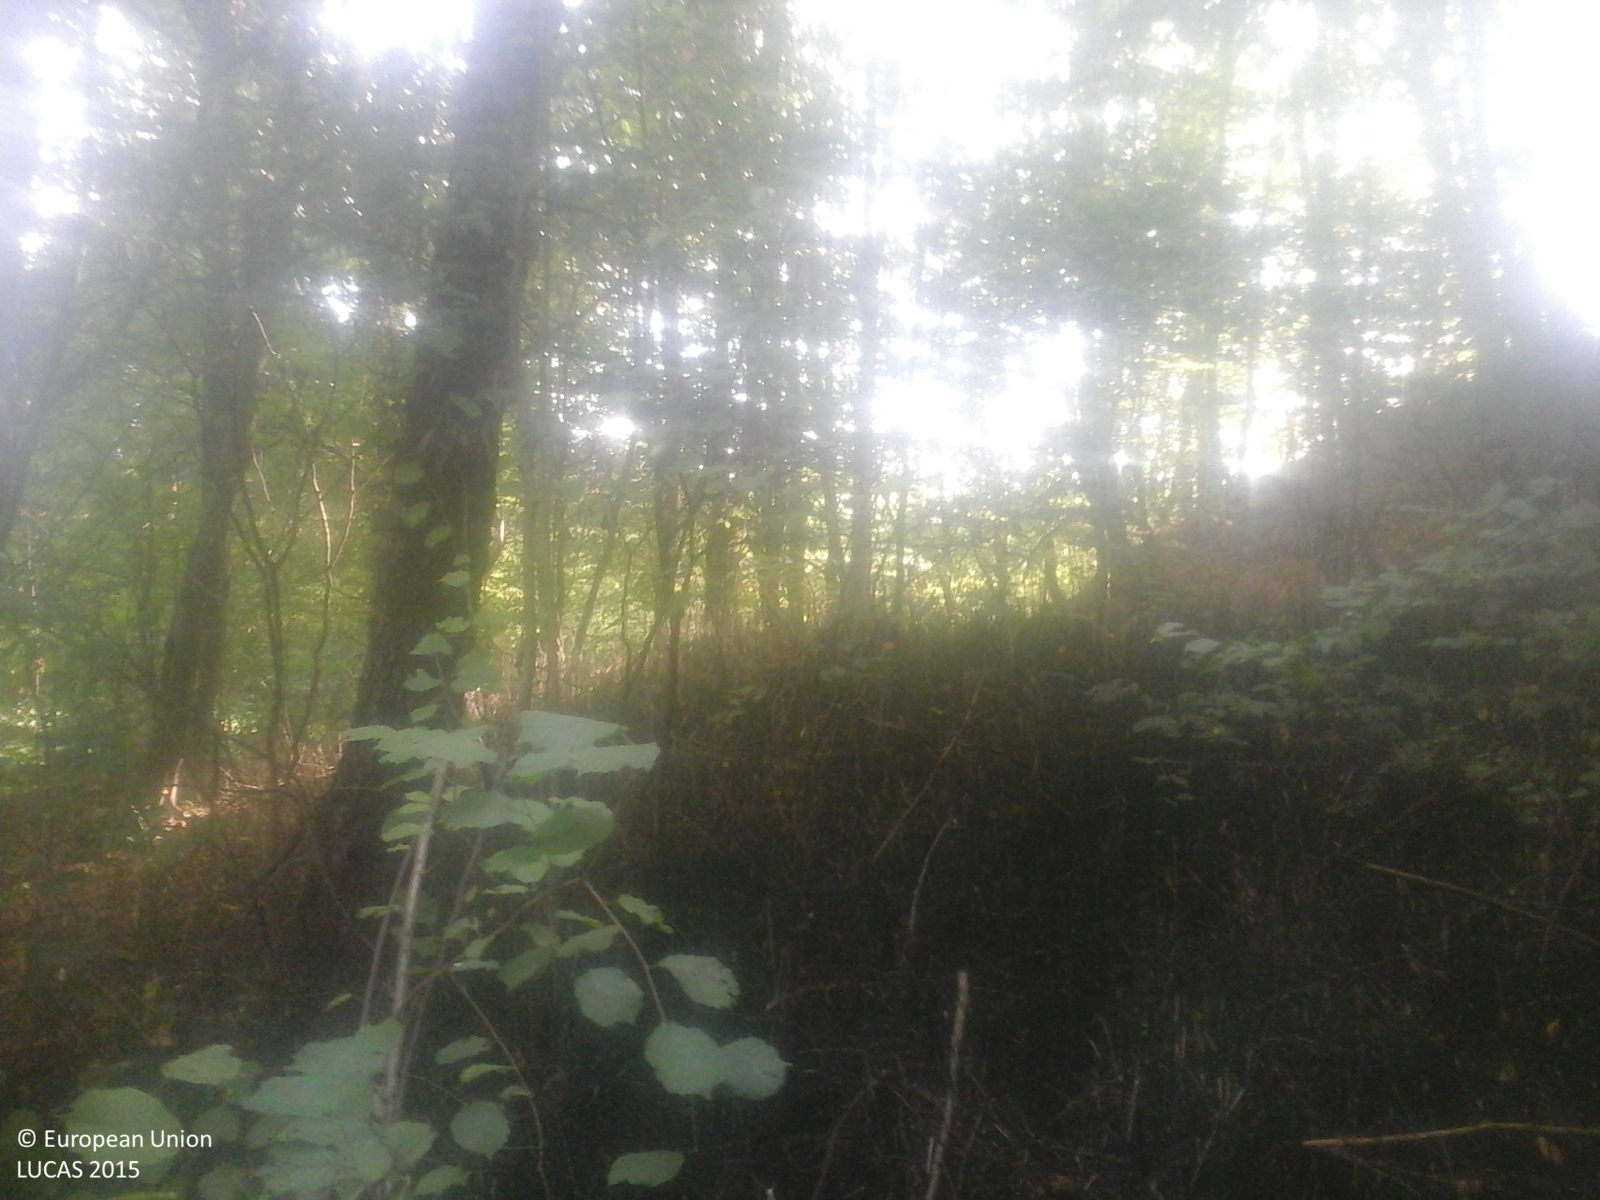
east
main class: Woodland
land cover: Broadleaved woodland
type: beech forest
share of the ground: > 75 %
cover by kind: broadleaved forest trees 100 %
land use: Forestry
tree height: > 5 m
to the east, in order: Broadleaved woodland; Spontaneously vegetated surfaces; Broadleaved woodland; Grassland without tree/shrub cover; Broadleaved woodland
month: September
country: RO
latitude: 46.0689
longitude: 22.8141
